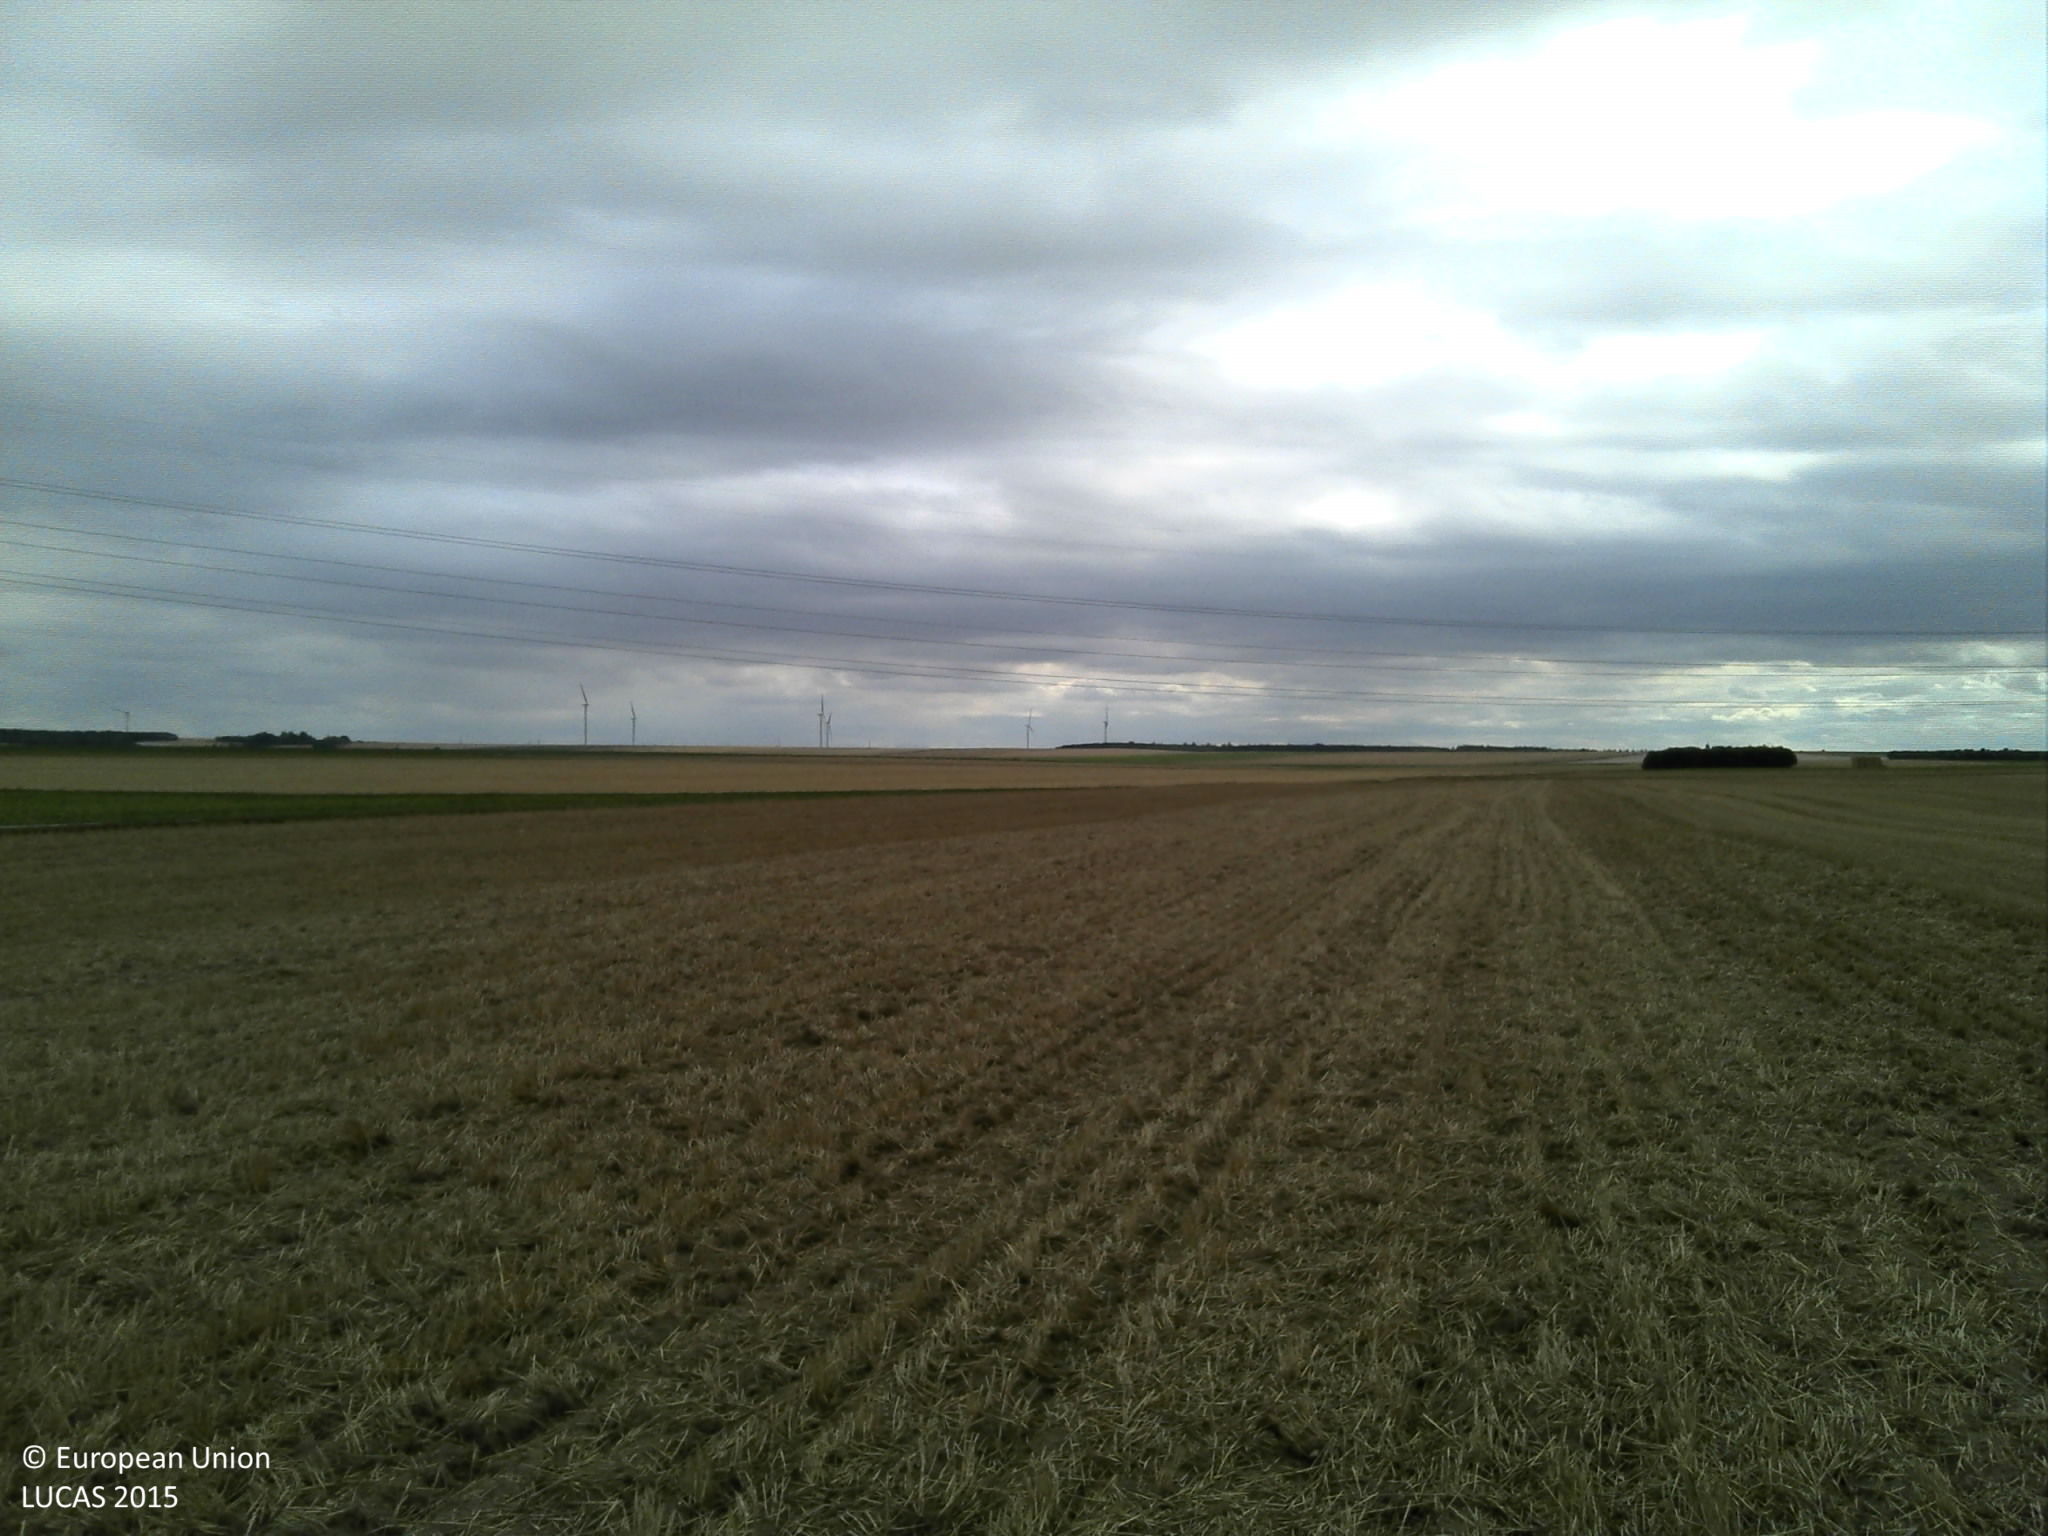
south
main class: Cropland
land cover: Common wheat
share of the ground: > 75 %
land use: Agriculture (excluding fallow land and kitchen gardens)
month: August
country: FR
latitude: 48.5212
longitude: 4.1879
